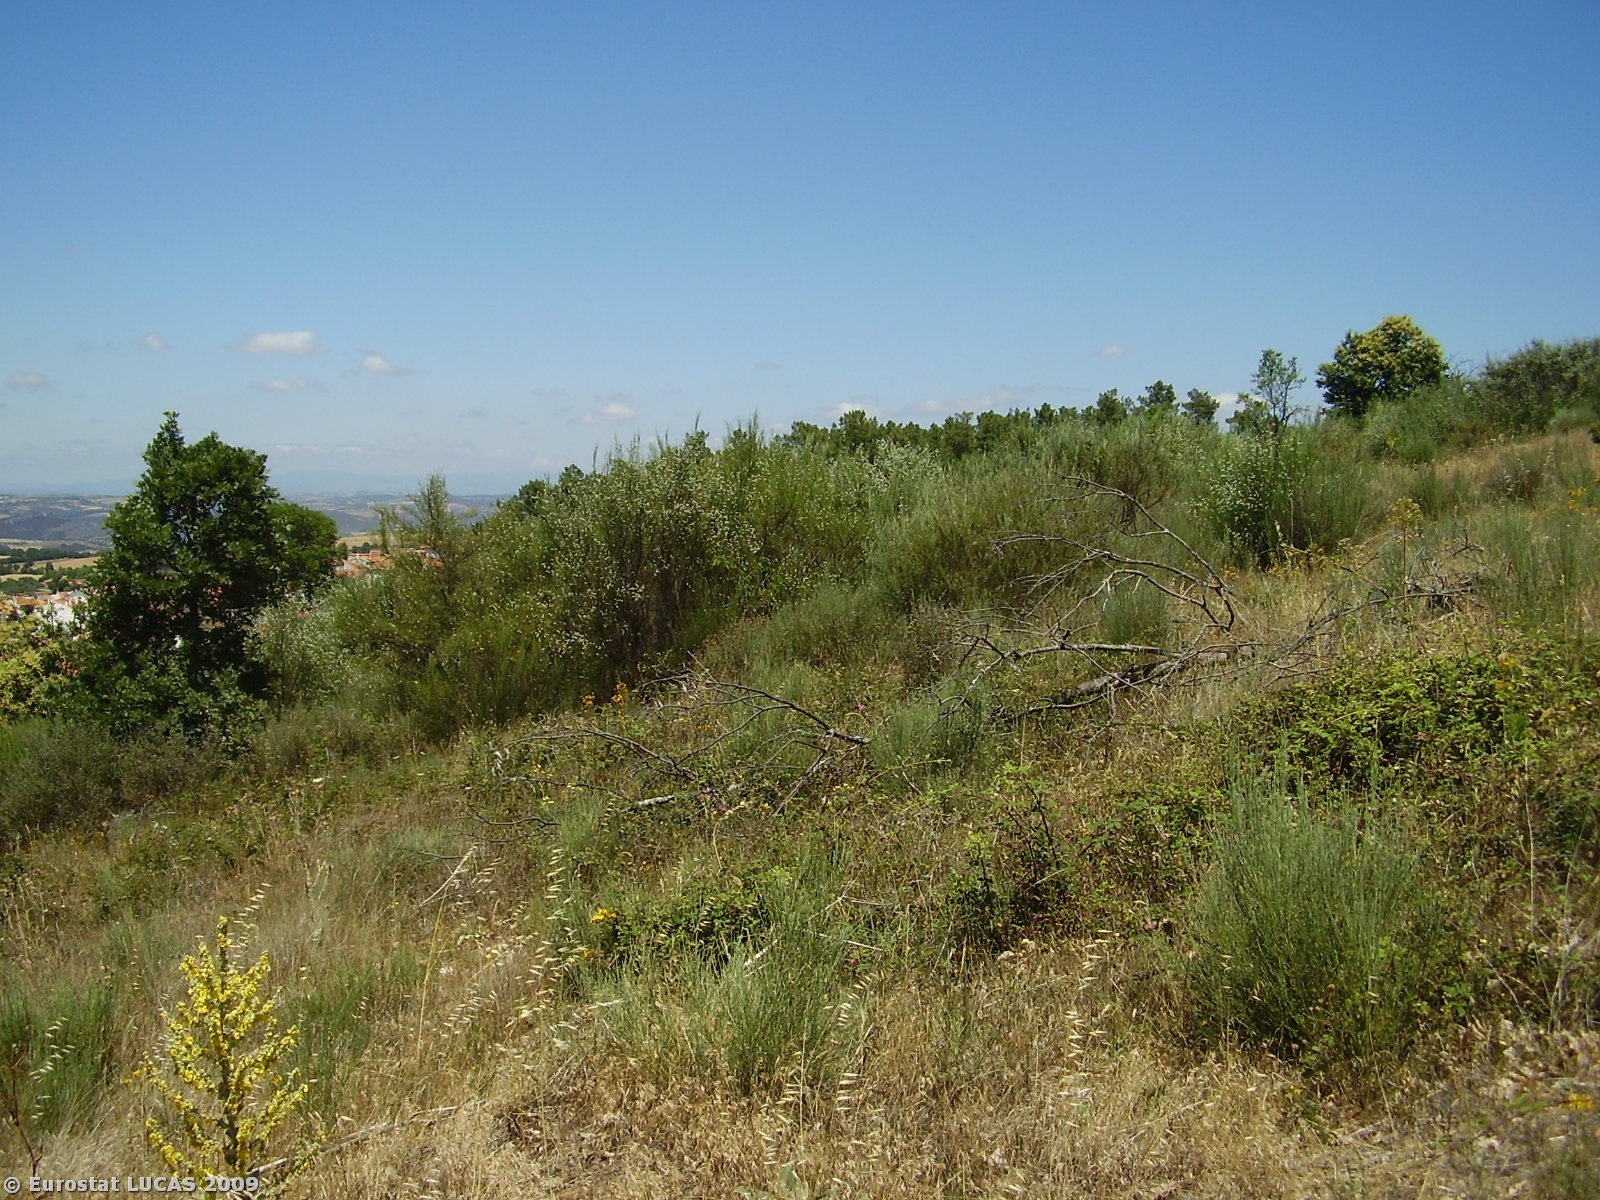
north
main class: Shrubland
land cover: Shrubland with sparse tree cover
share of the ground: 10 - 25 %
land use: Unused
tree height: > 5 m
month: June
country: PT
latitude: 41.5801
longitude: -6.5246
